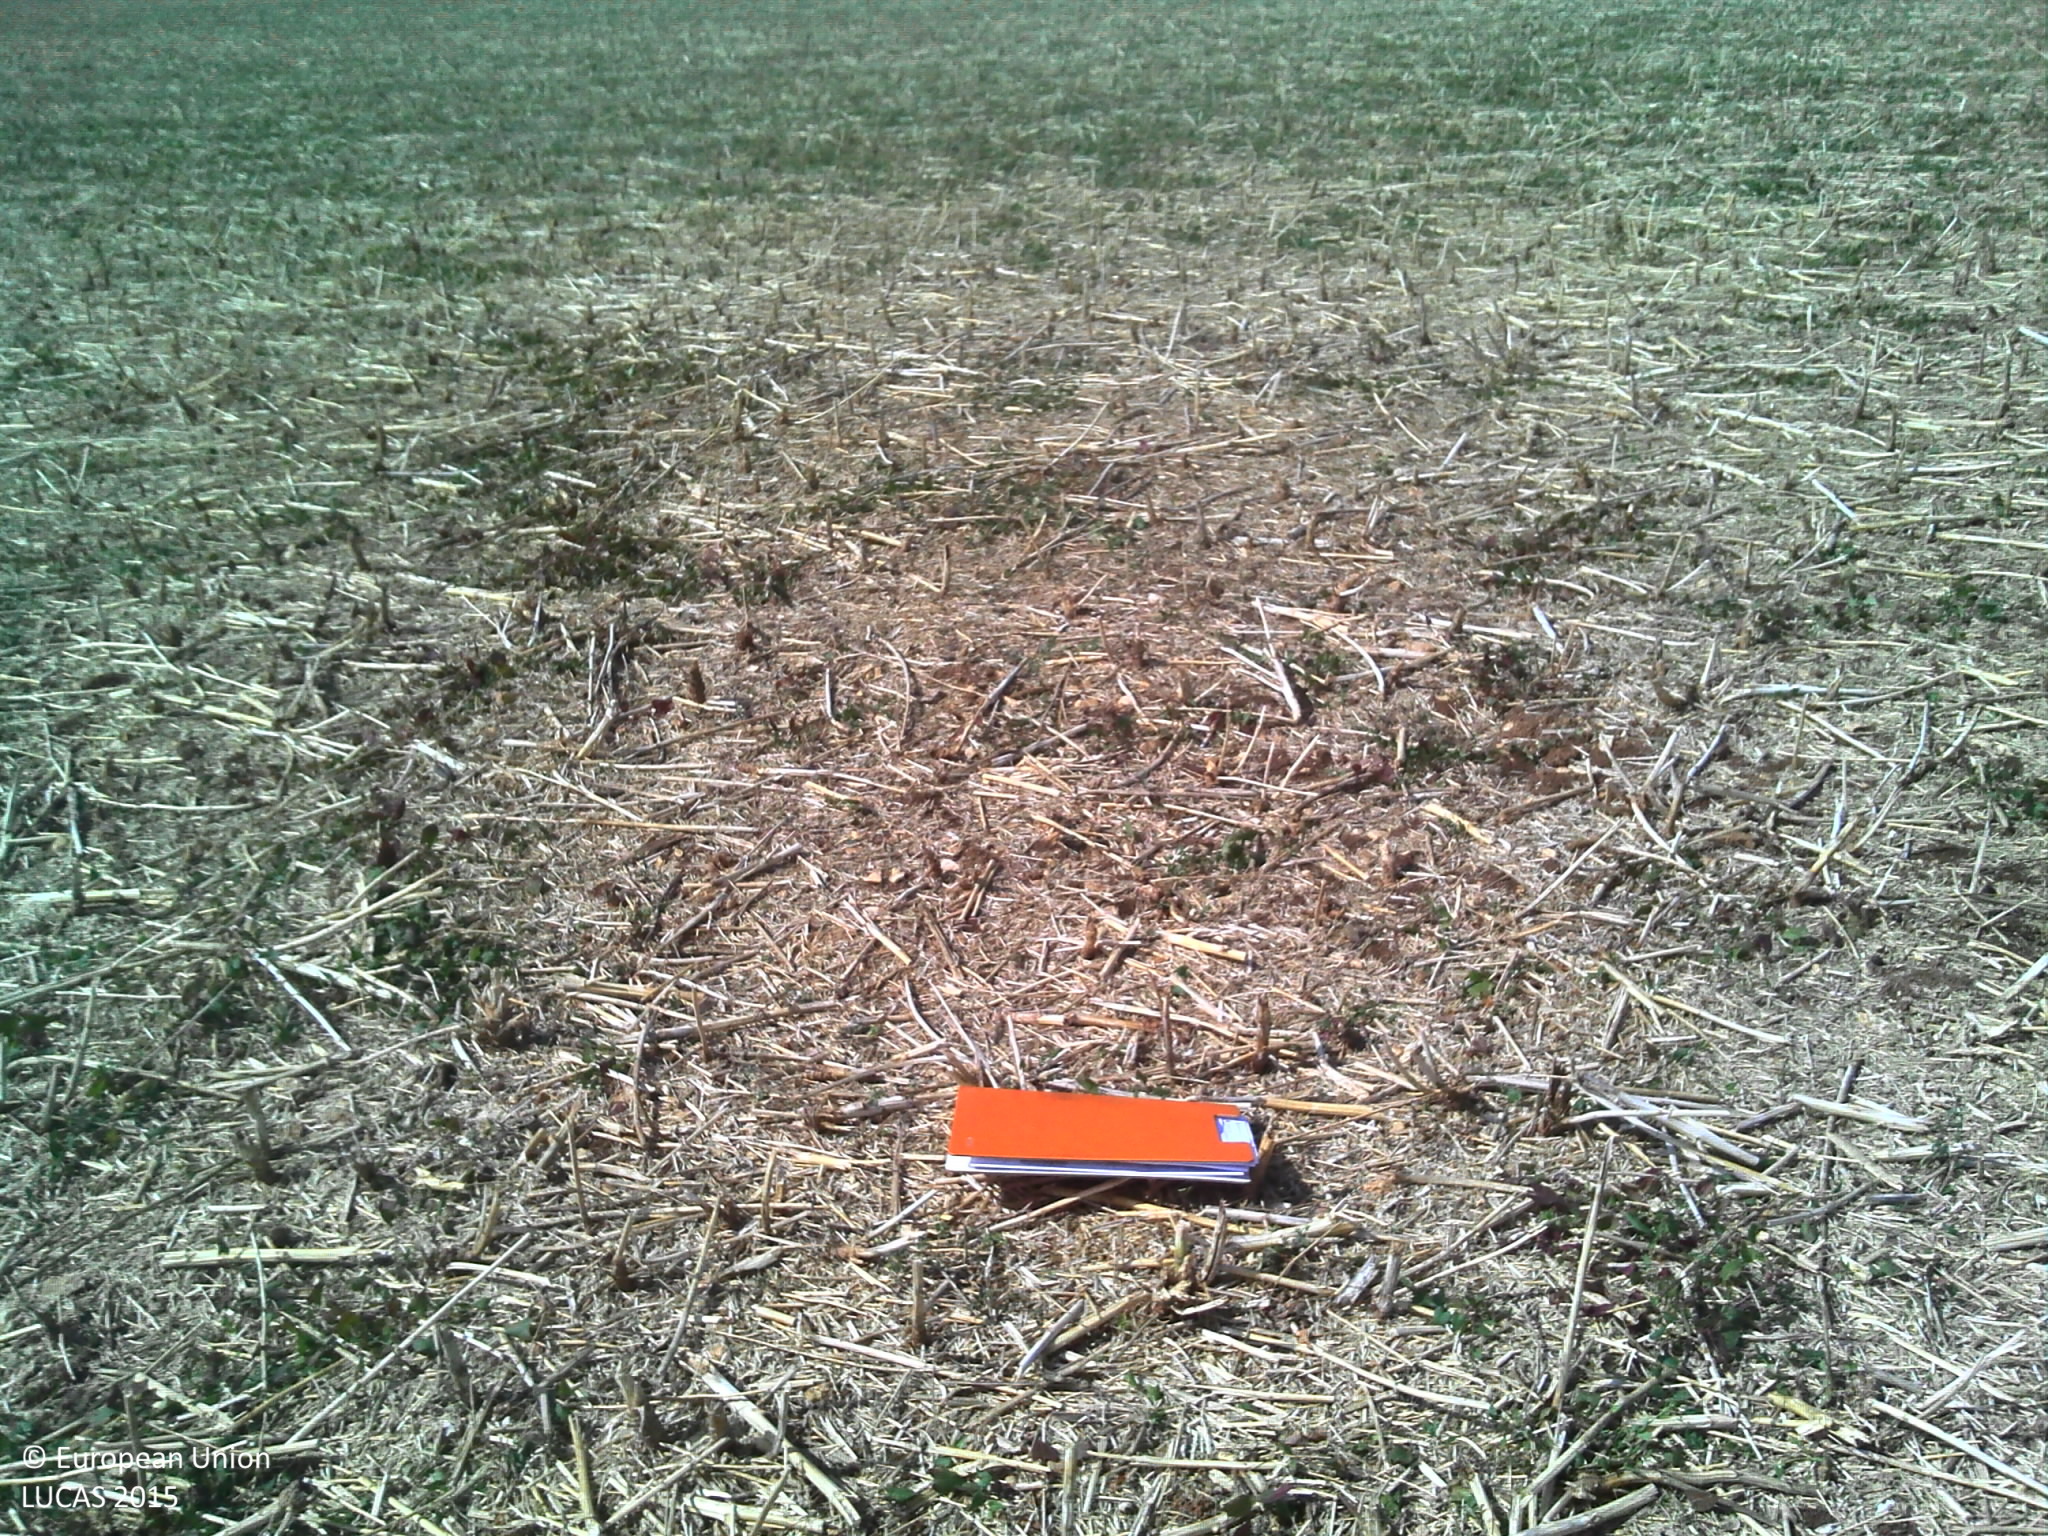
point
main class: Cropland
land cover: Rape and turnip rape
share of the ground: 10 - 25 %
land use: Agriculture (excluding fallow land and kitchen gardens)
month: August
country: FR
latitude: 47.7686
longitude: 5.0226
